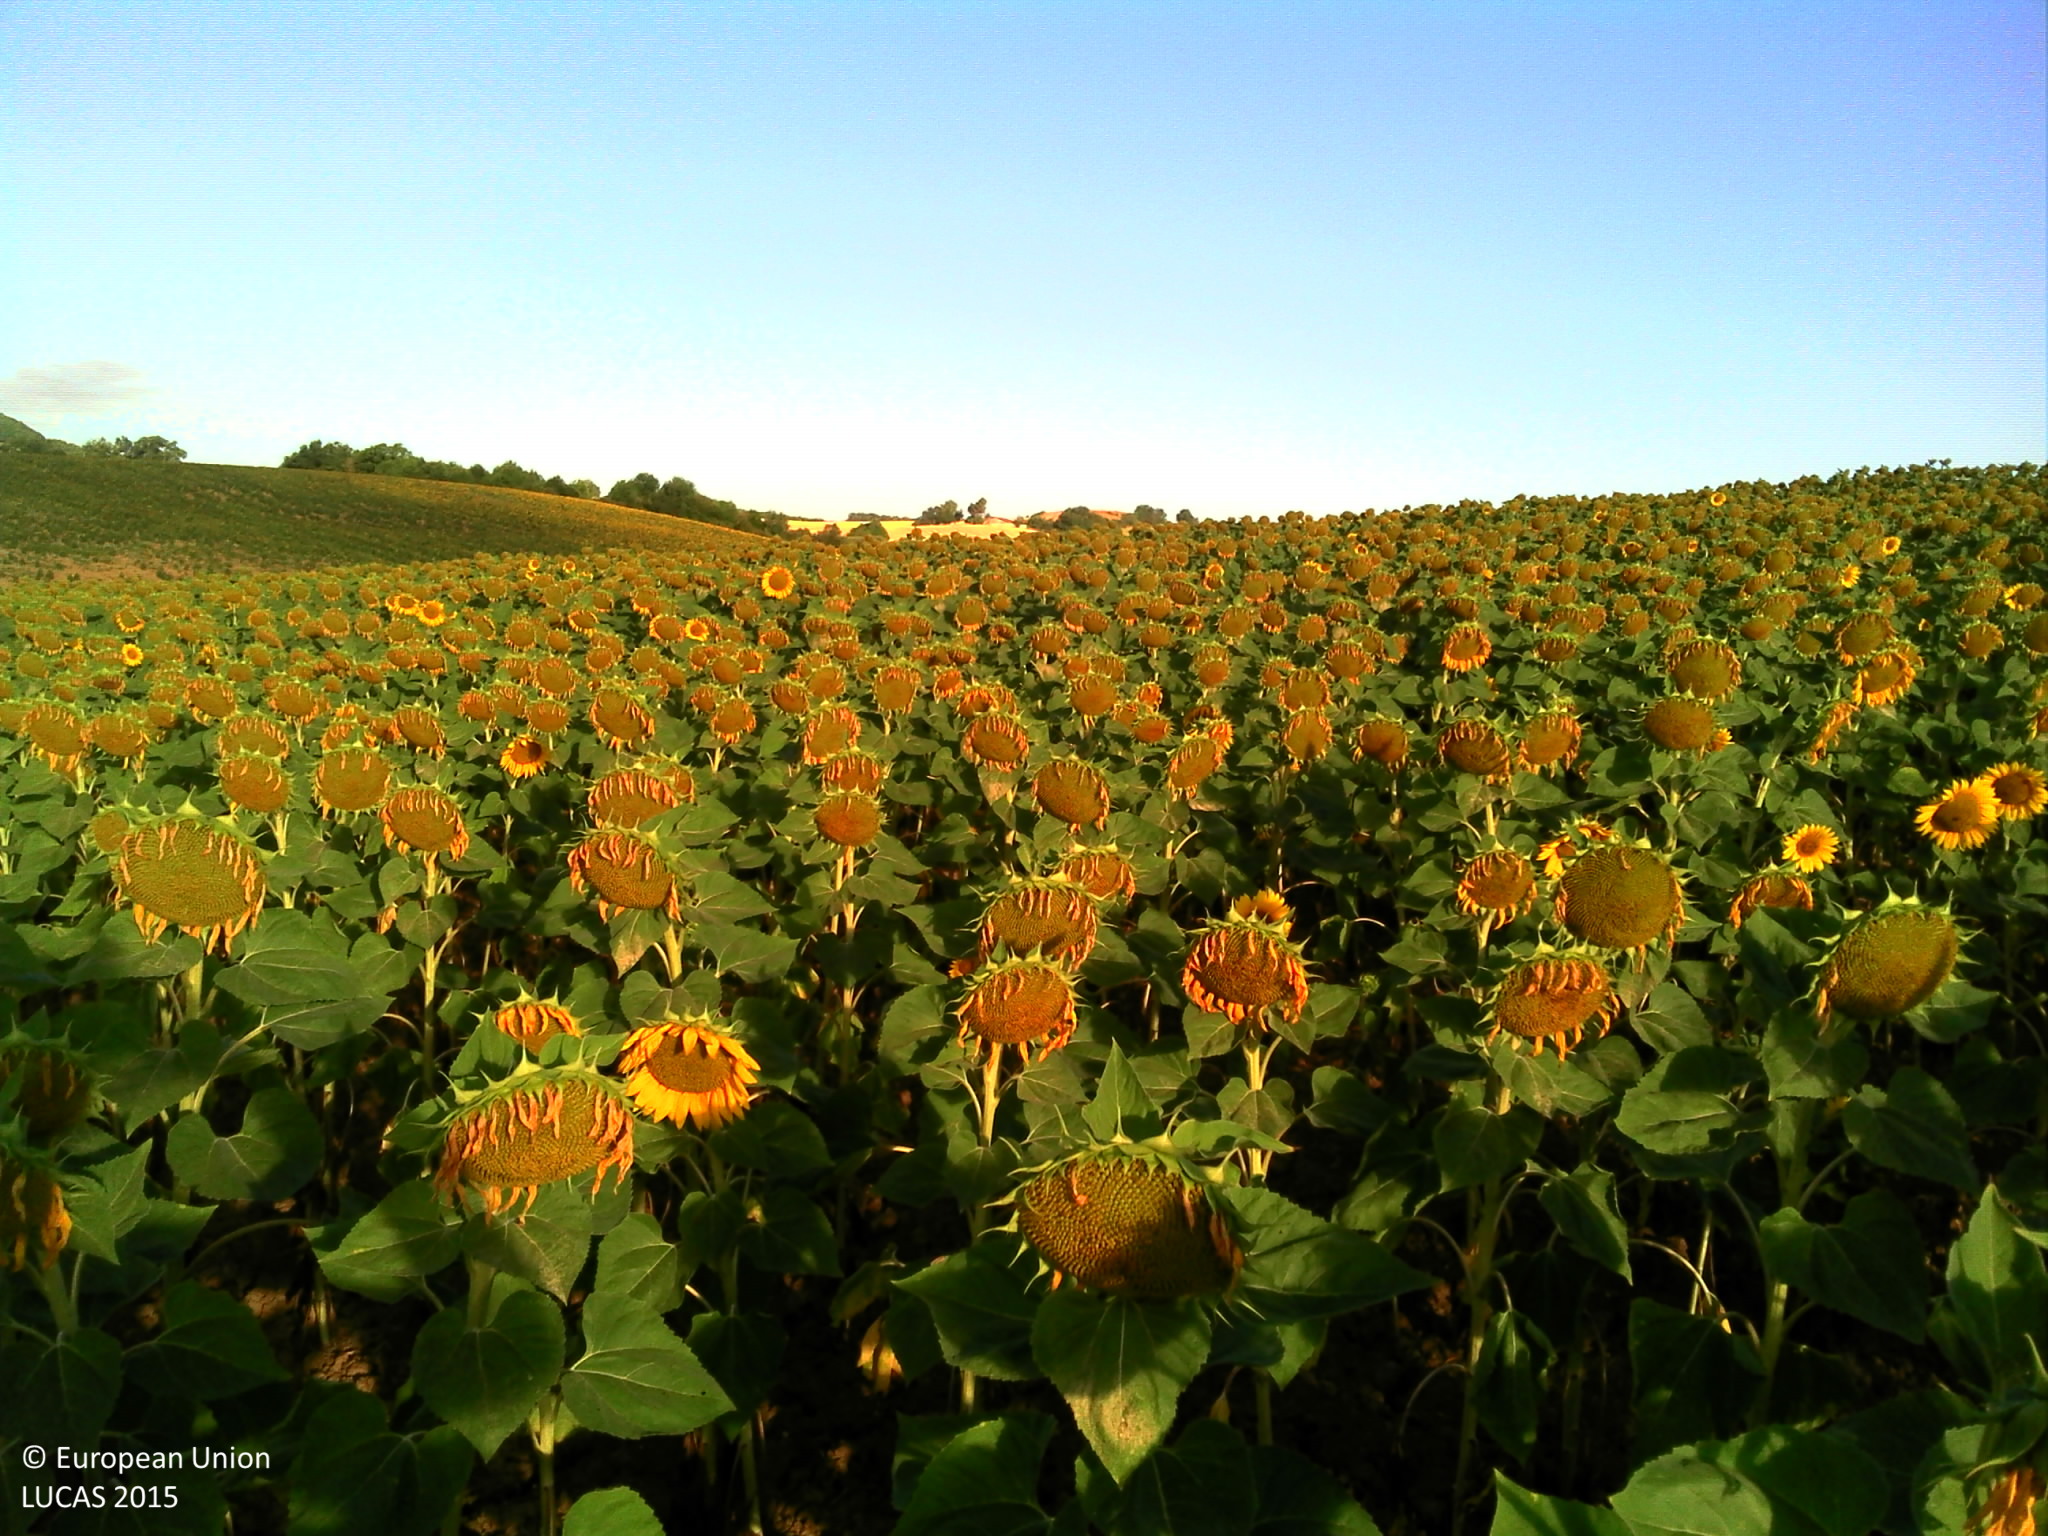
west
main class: Cropland
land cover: Sunflower
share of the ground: 50 - 75 %
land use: Agriculture (excluding fallow land and kitchen gardens)
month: July
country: FR
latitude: 44.4989
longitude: 0.5474
